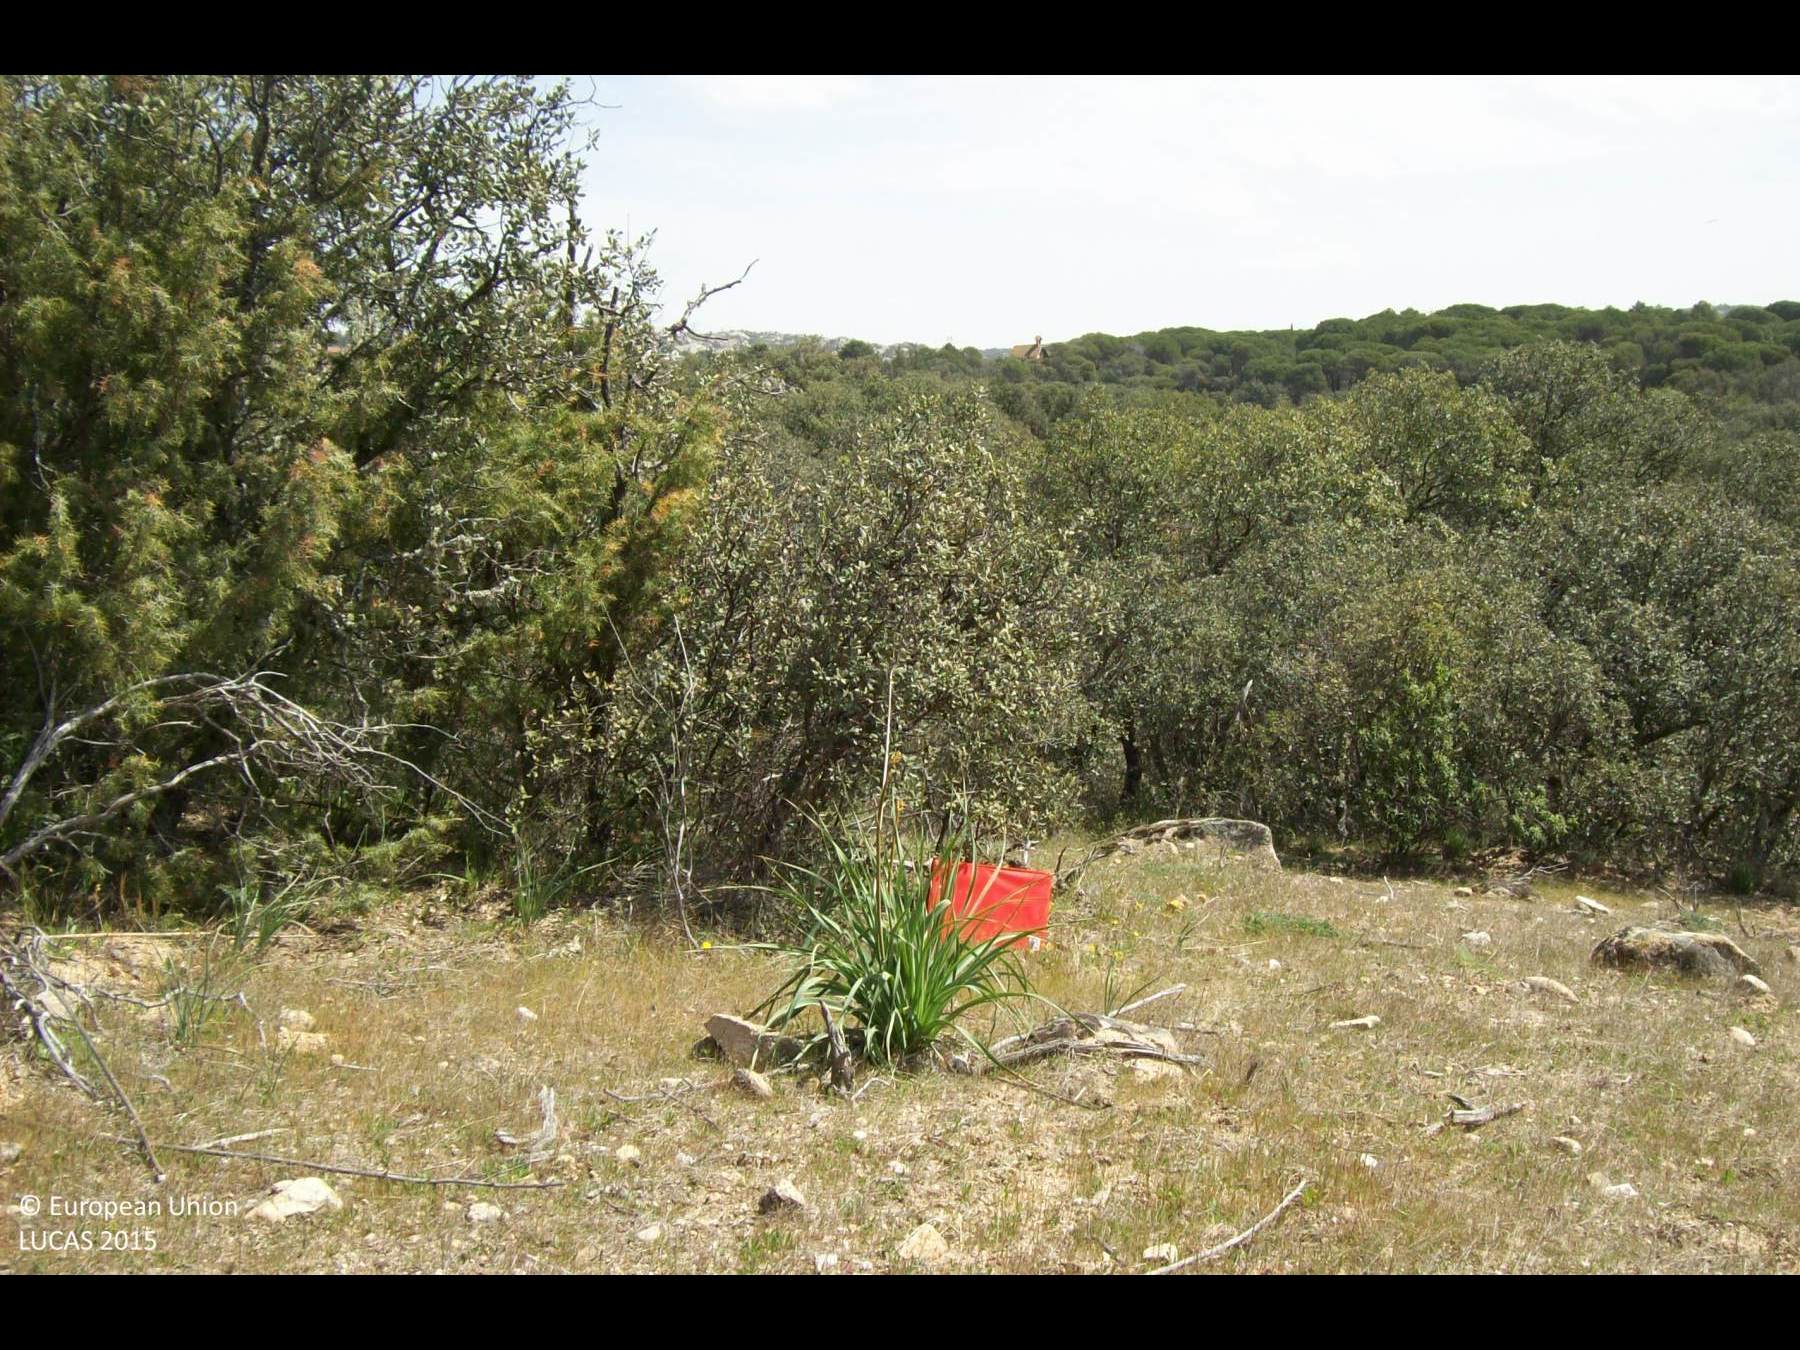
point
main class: Woodland
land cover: Broadleaved woodland
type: broadleaved evergreen forest
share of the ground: 25 - 50 %
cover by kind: herbaceous plants 50 %, broadleaved forest trees 25 %, shrubs 25 %
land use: Semi-natural and natural areas not in use
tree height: < 5 m
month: April
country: ES
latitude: 40.6026
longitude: -3.9529
